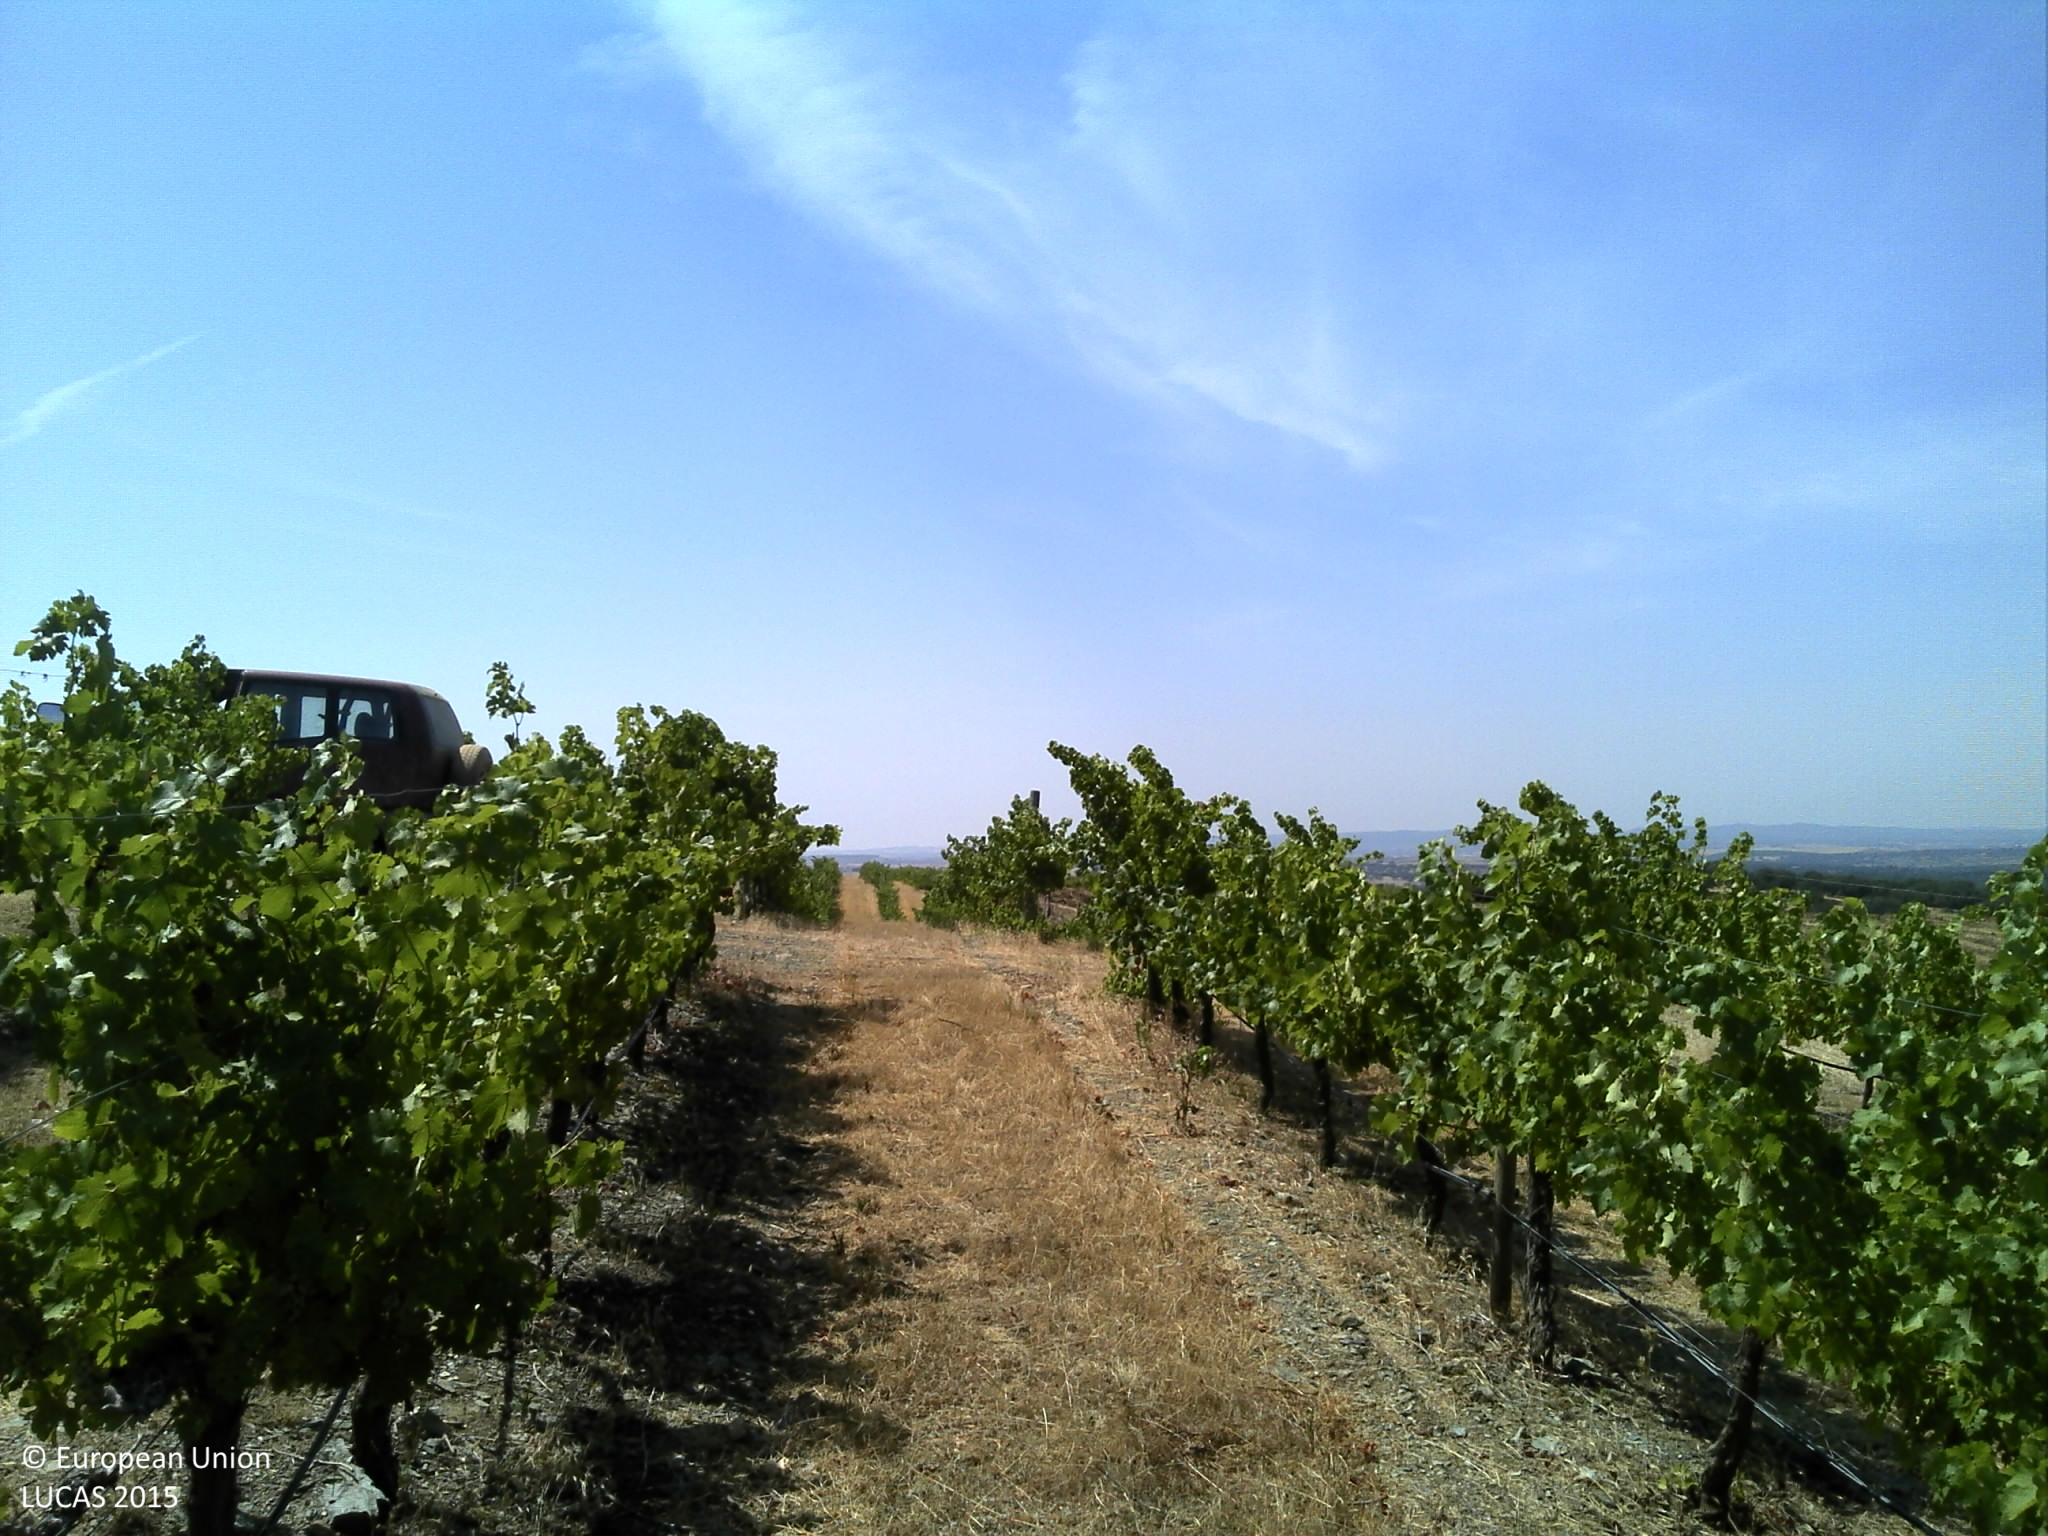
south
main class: Cropland
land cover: Vineyards
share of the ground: 25 - 50 %
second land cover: Grassland without tree/shrub cover
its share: 25 - 50 %
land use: Agriculture (excluding fallow land and kitchen gardens)
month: July
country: PT
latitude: 38.5037
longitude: -7.6570
